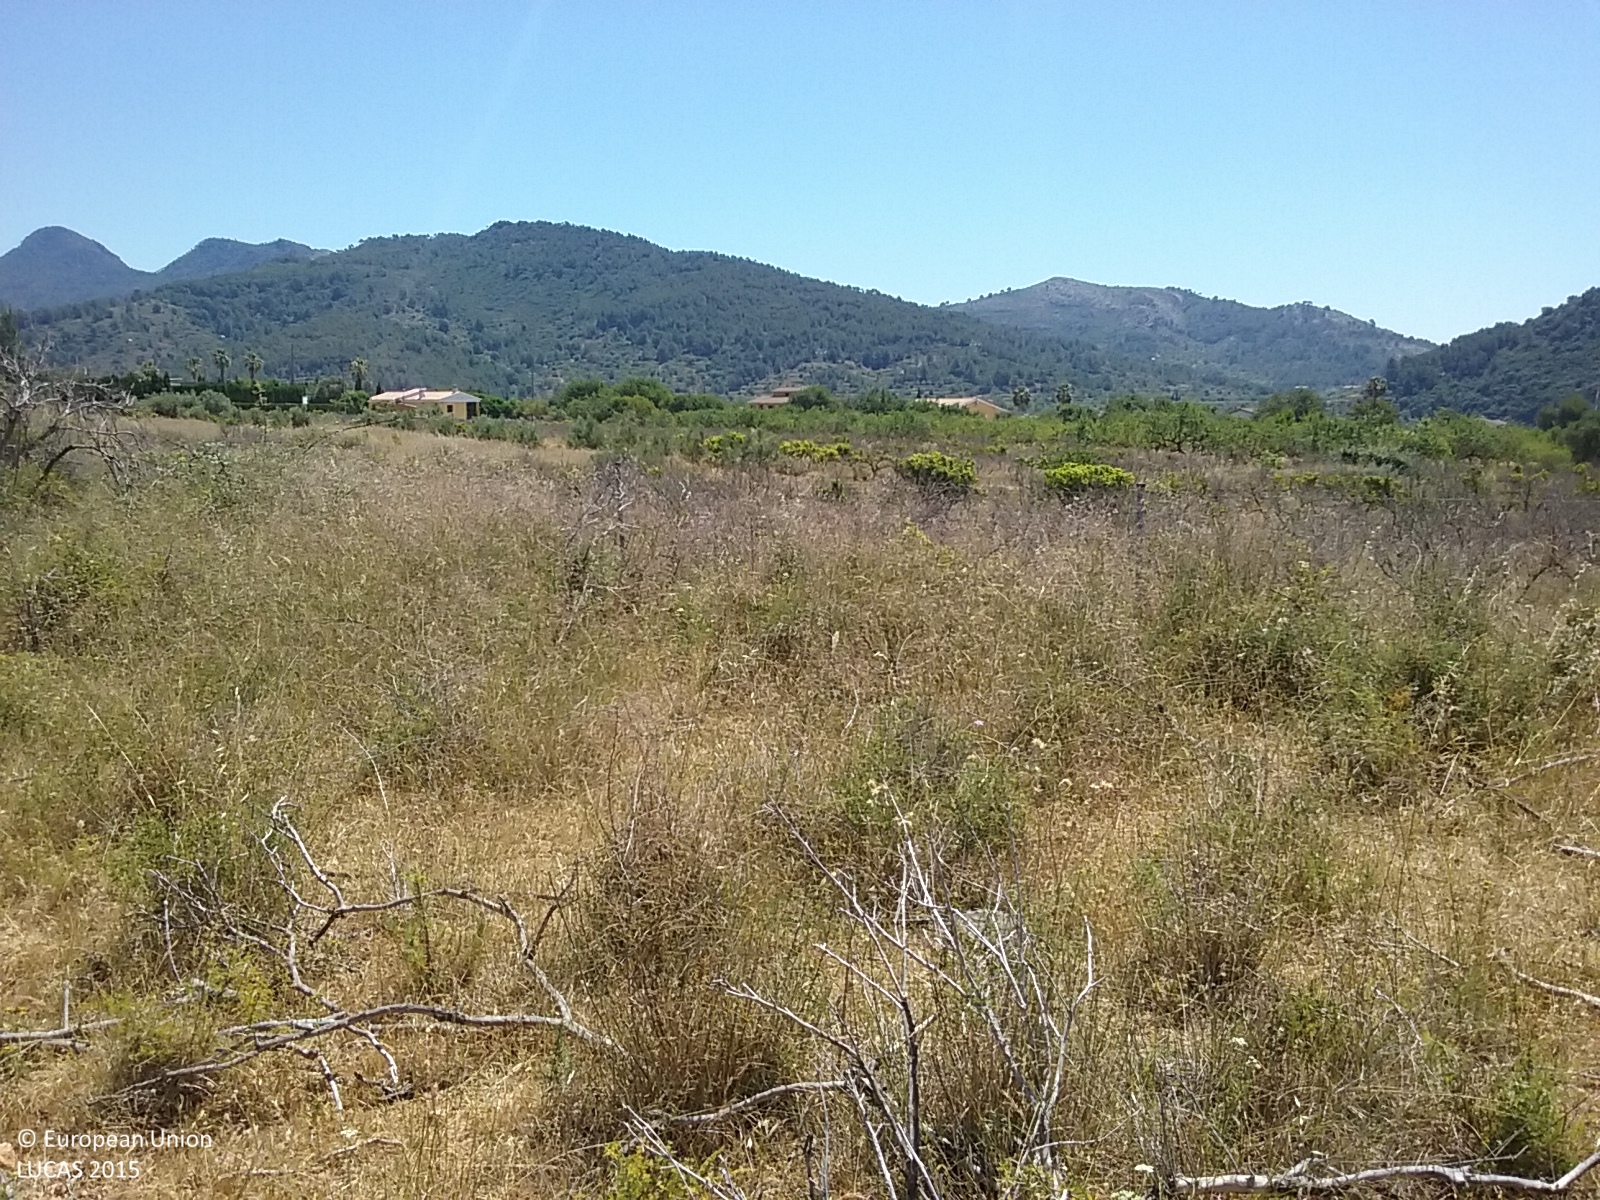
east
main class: Shrubland
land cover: Shrubland without tree cover
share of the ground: 10 - 25 %
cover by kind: herbaceous plants 80 %, shrubs 15 %, unconsolidated bare surface 5 %
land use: Abandoned areas
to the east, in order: Shrubland without tree cover; Dry stone walls; Fences; Oranges; Dry stone walls; Ditches and canals; Dry stone walls; Oranges; Dry stone walls; Olive groves; Oranges; Artificial constructions in urban areas; Nuts trees
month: June
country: ES
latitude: 40.0598
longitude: -0.0488
